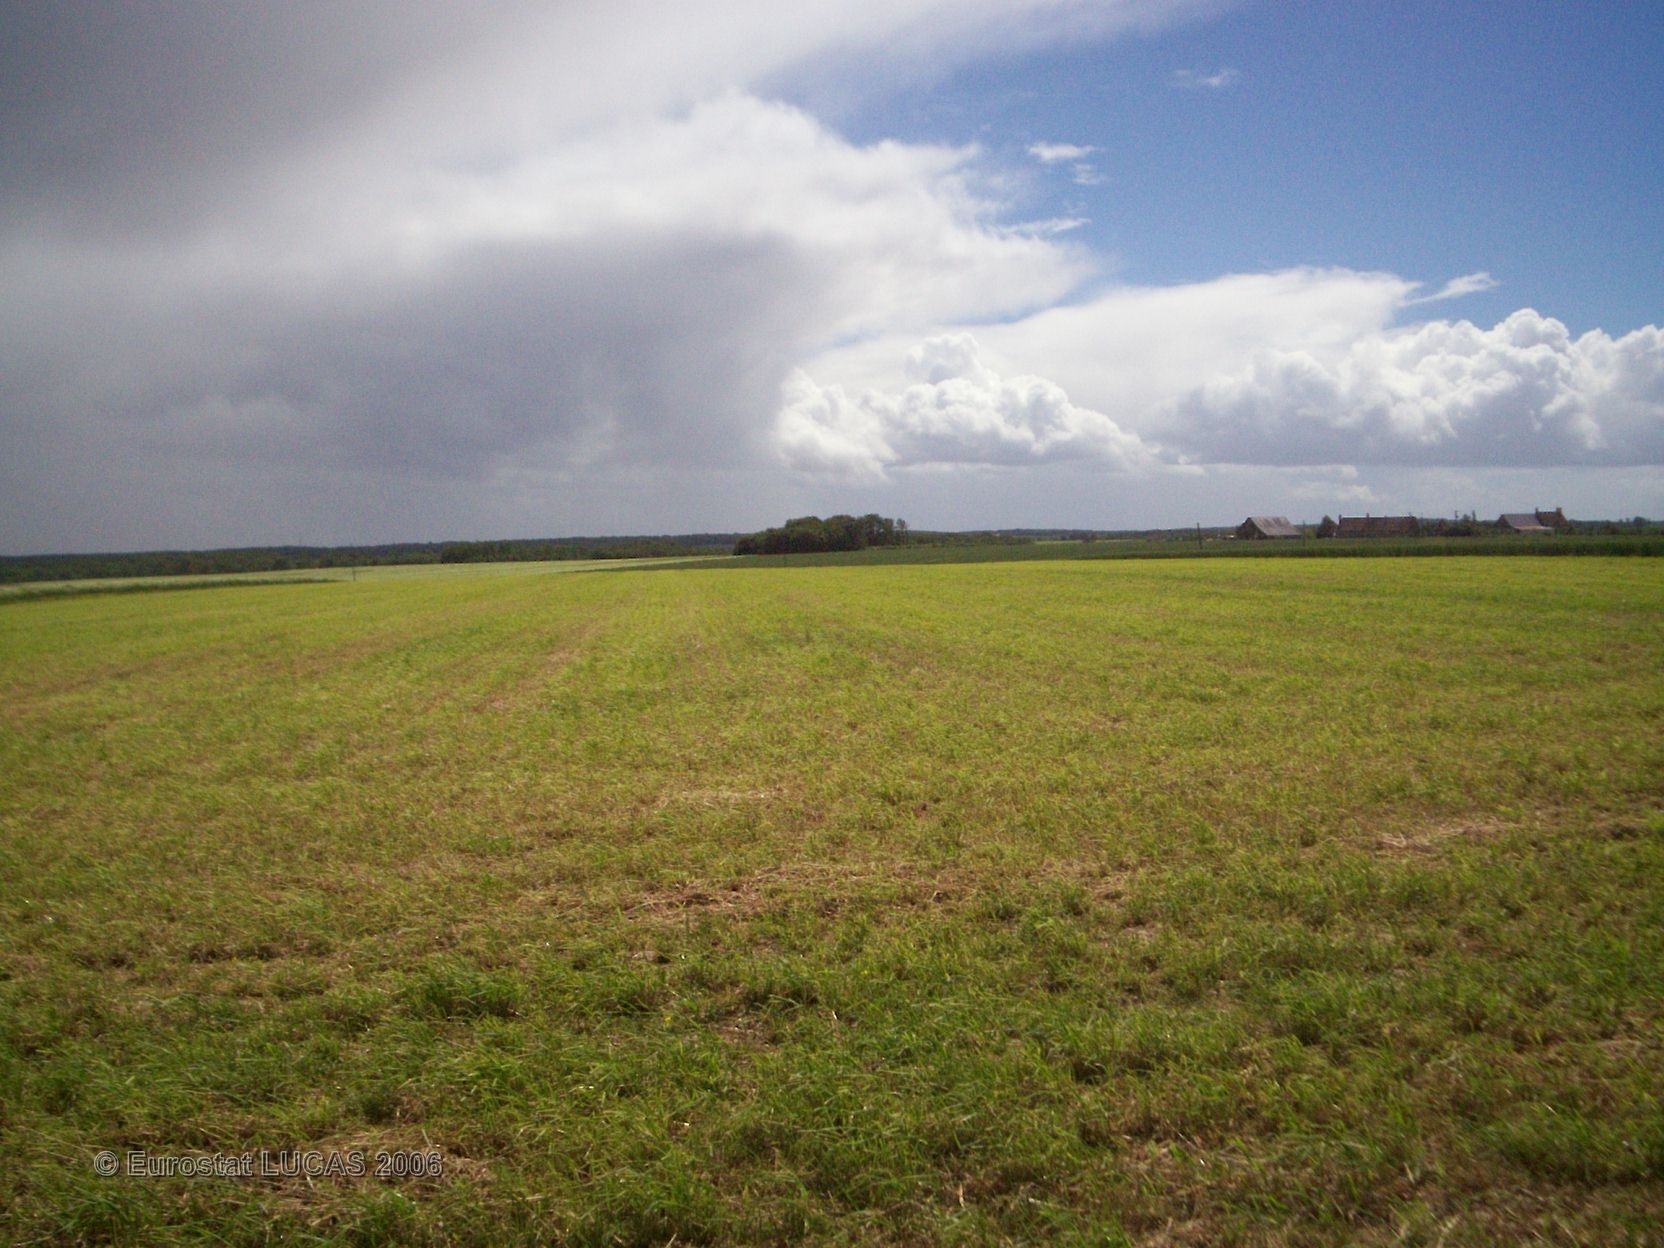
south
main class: Grassland
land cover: Grassland without tree/shrub cover
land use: Agriculture (excluding fallow land and kitchen gardens)
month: May
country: FR
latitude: 47.6241
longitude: 0.8393
